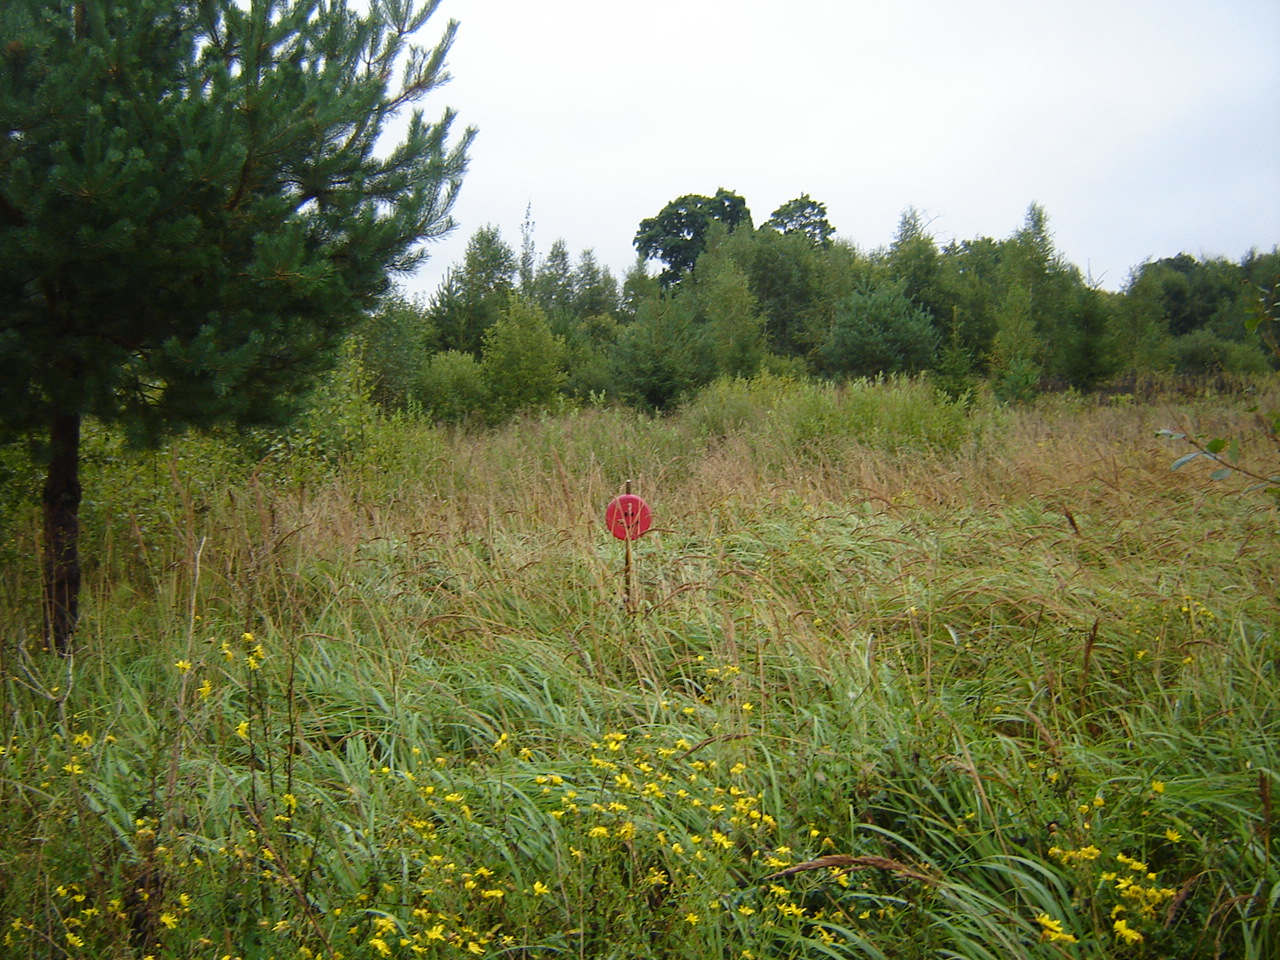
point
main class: Woodland
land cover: Pine dominated mixed woodland
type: hemiboreal forest and nemoral coniferous forest and mixed broadleaved-coniferous forest
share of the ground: 25 - 50 %
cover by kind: herbaceous plants 70 %, broadleaved forest trees 20 %, coniferous forest trees 10 %
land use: Forestry
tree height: < 5 m
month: September
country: LT
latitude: 54.8926
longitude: 25.3234
